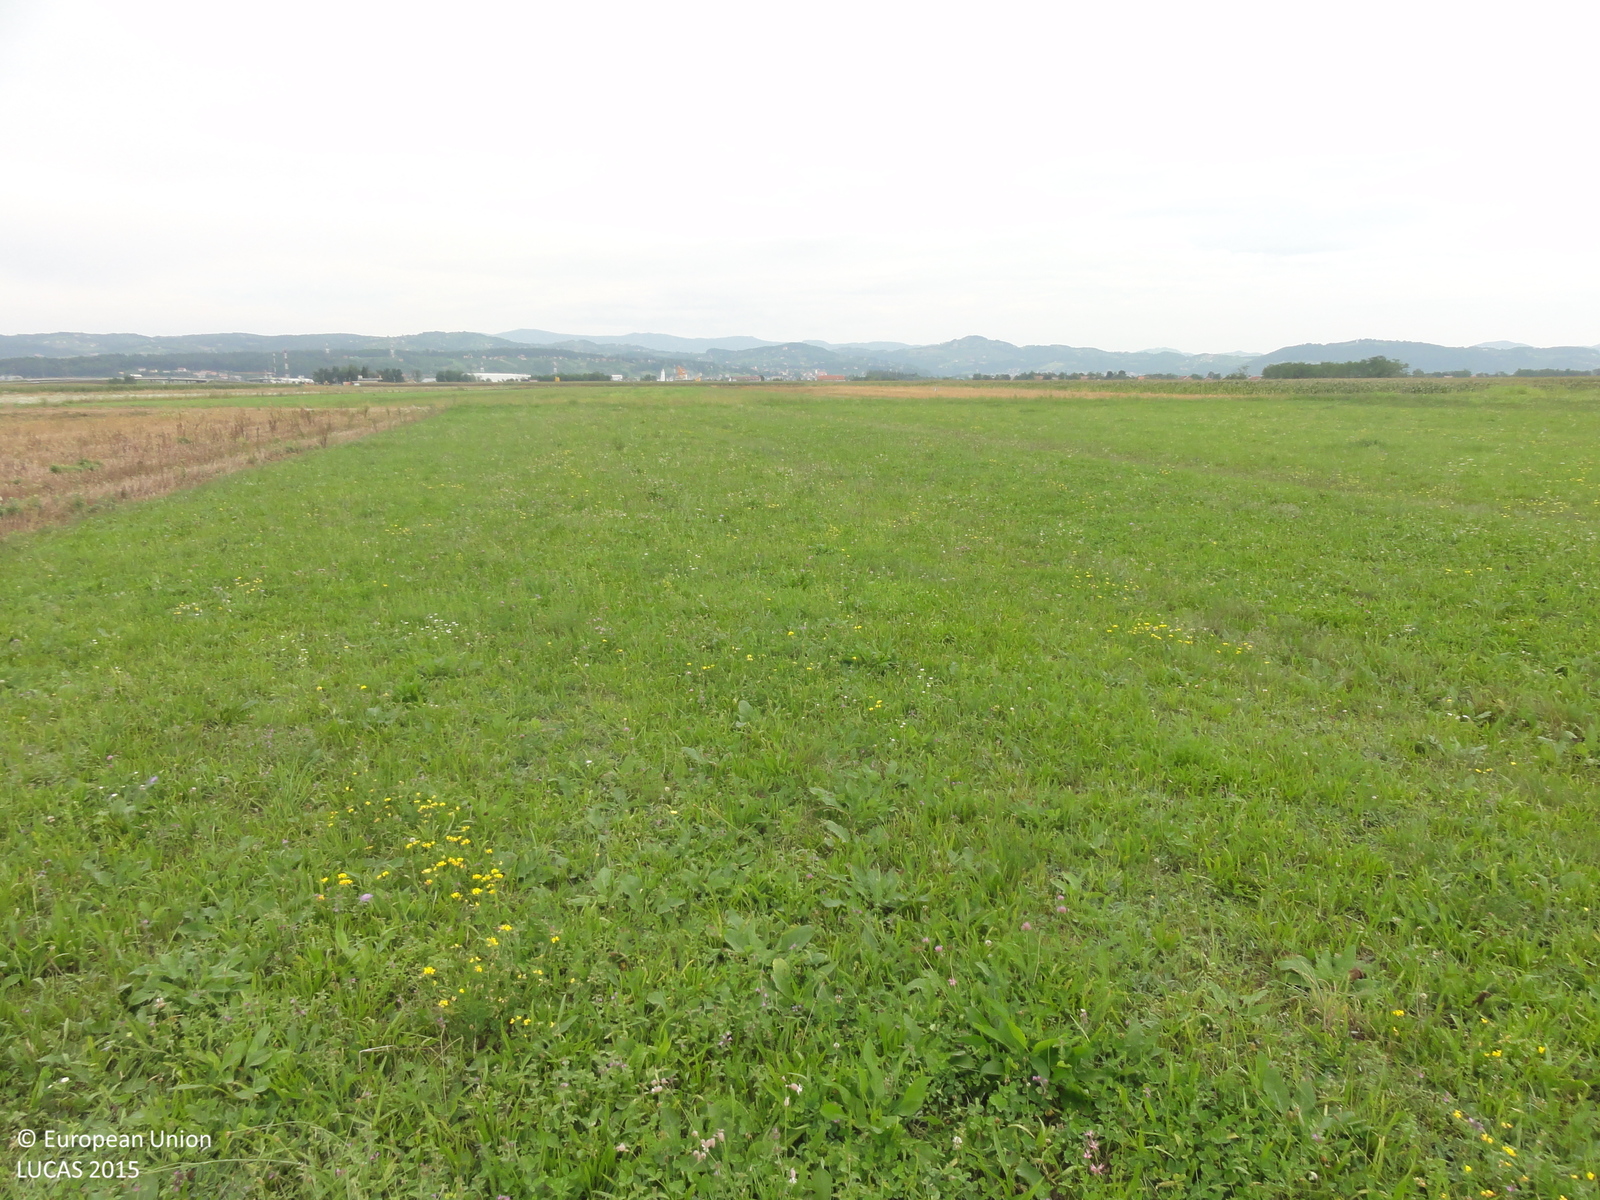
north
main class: Grassland
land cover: Grassland without tree/shrub cover
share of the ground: > 75 %
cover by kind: herbaceous plants 100 %
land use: Agriculture (excluding fallow land and kitchen gardens)
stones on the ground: < 10 %
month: August
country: SI
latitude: 45.9041
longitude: 15.4755
